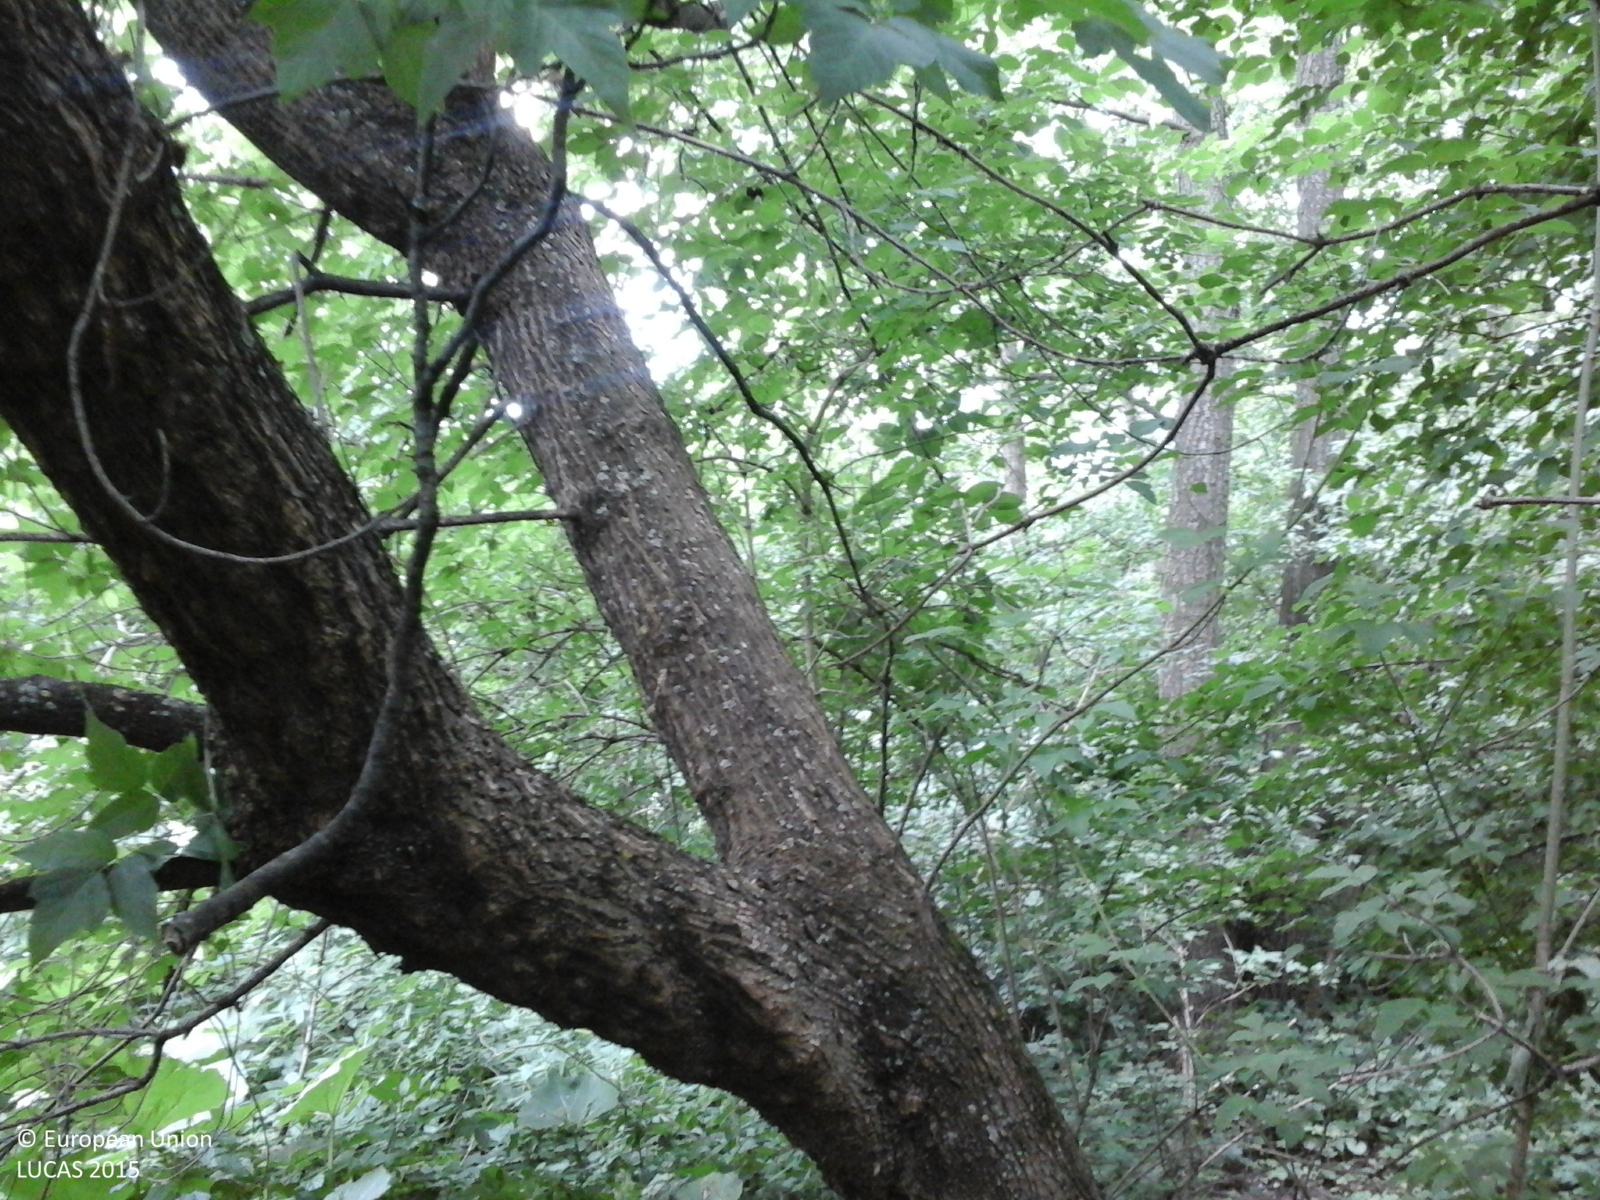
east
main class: Woodland
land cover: Broadleaved woodland
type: non-riverine alder, birch or aspen forest
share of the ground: > 75 %
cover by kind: broadleaved forest trees 100 %
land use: Forestry
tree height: > 5 m
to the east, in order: Broadleaved woodland; Grassland with sparse tree/shrub cover; Grassland without tree/shrub cover; Broadleaved woodland
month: June
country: RO
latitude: 47.4806
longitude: 26.3952
